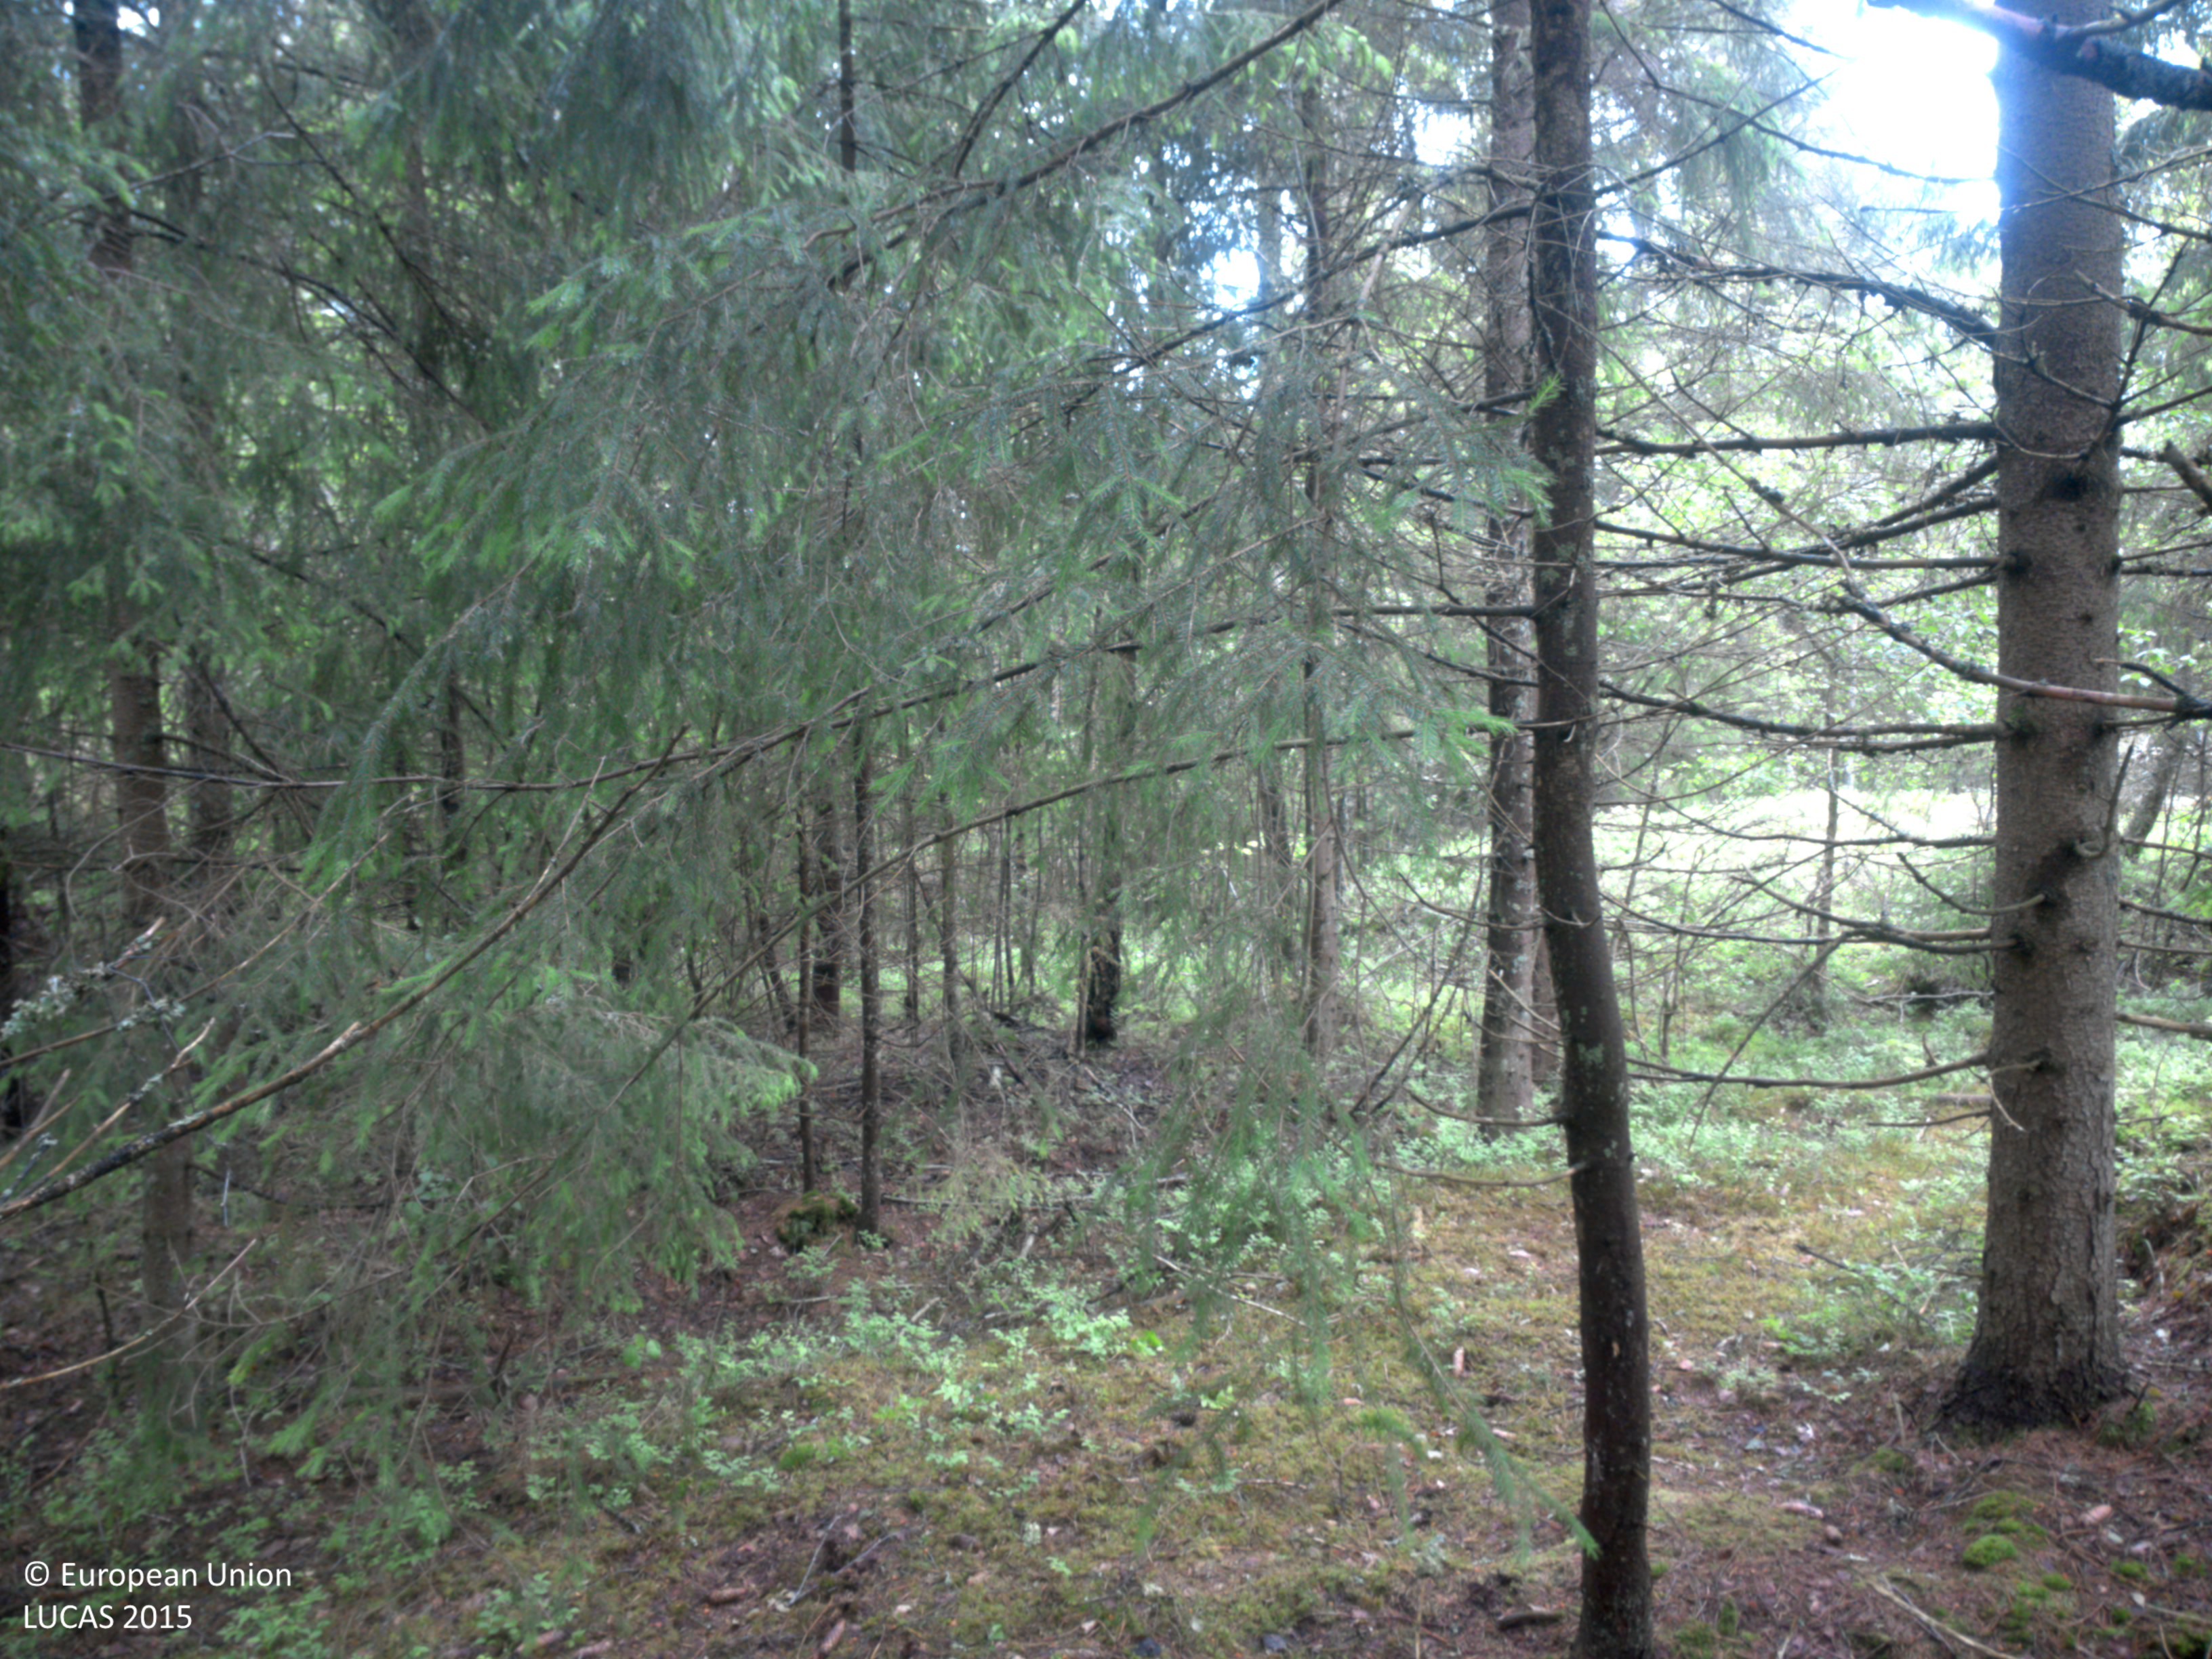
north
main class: Woodland
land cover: Spruce dominated coniferous woodland
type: boreal forest
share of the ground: 50 - 75 %
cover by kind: coniferous forest trees 50 %, lichens and mosses 40 %, broadleaved forest trees 5 %, shrubs 5 %
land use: Forestry
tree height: > 5 m
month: June
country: SE
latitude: 58.4773
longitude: 11.7968
